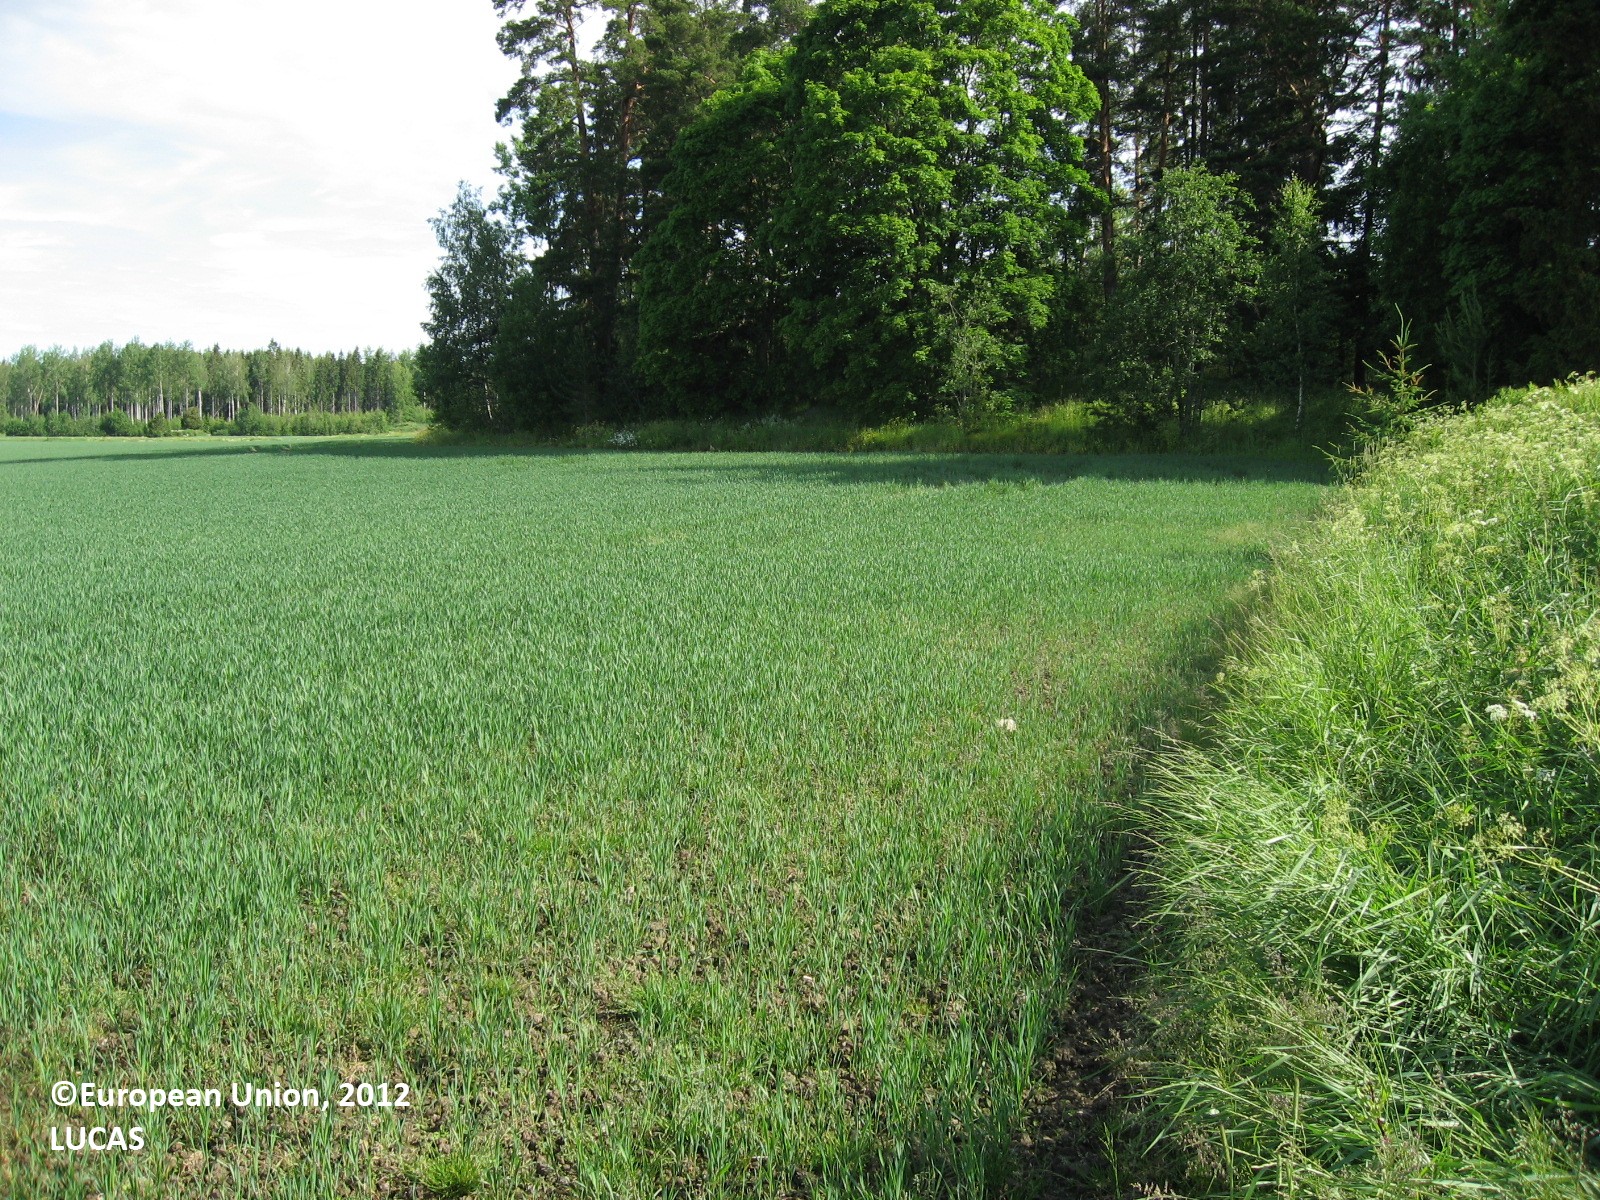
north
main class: Cropland
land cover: Common wheat
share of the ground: 50 - 75 %
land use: Agriculture (excluding fallow land and kitchen gardens)
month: June
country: FI
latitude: 60.6908
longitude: 26.2069
